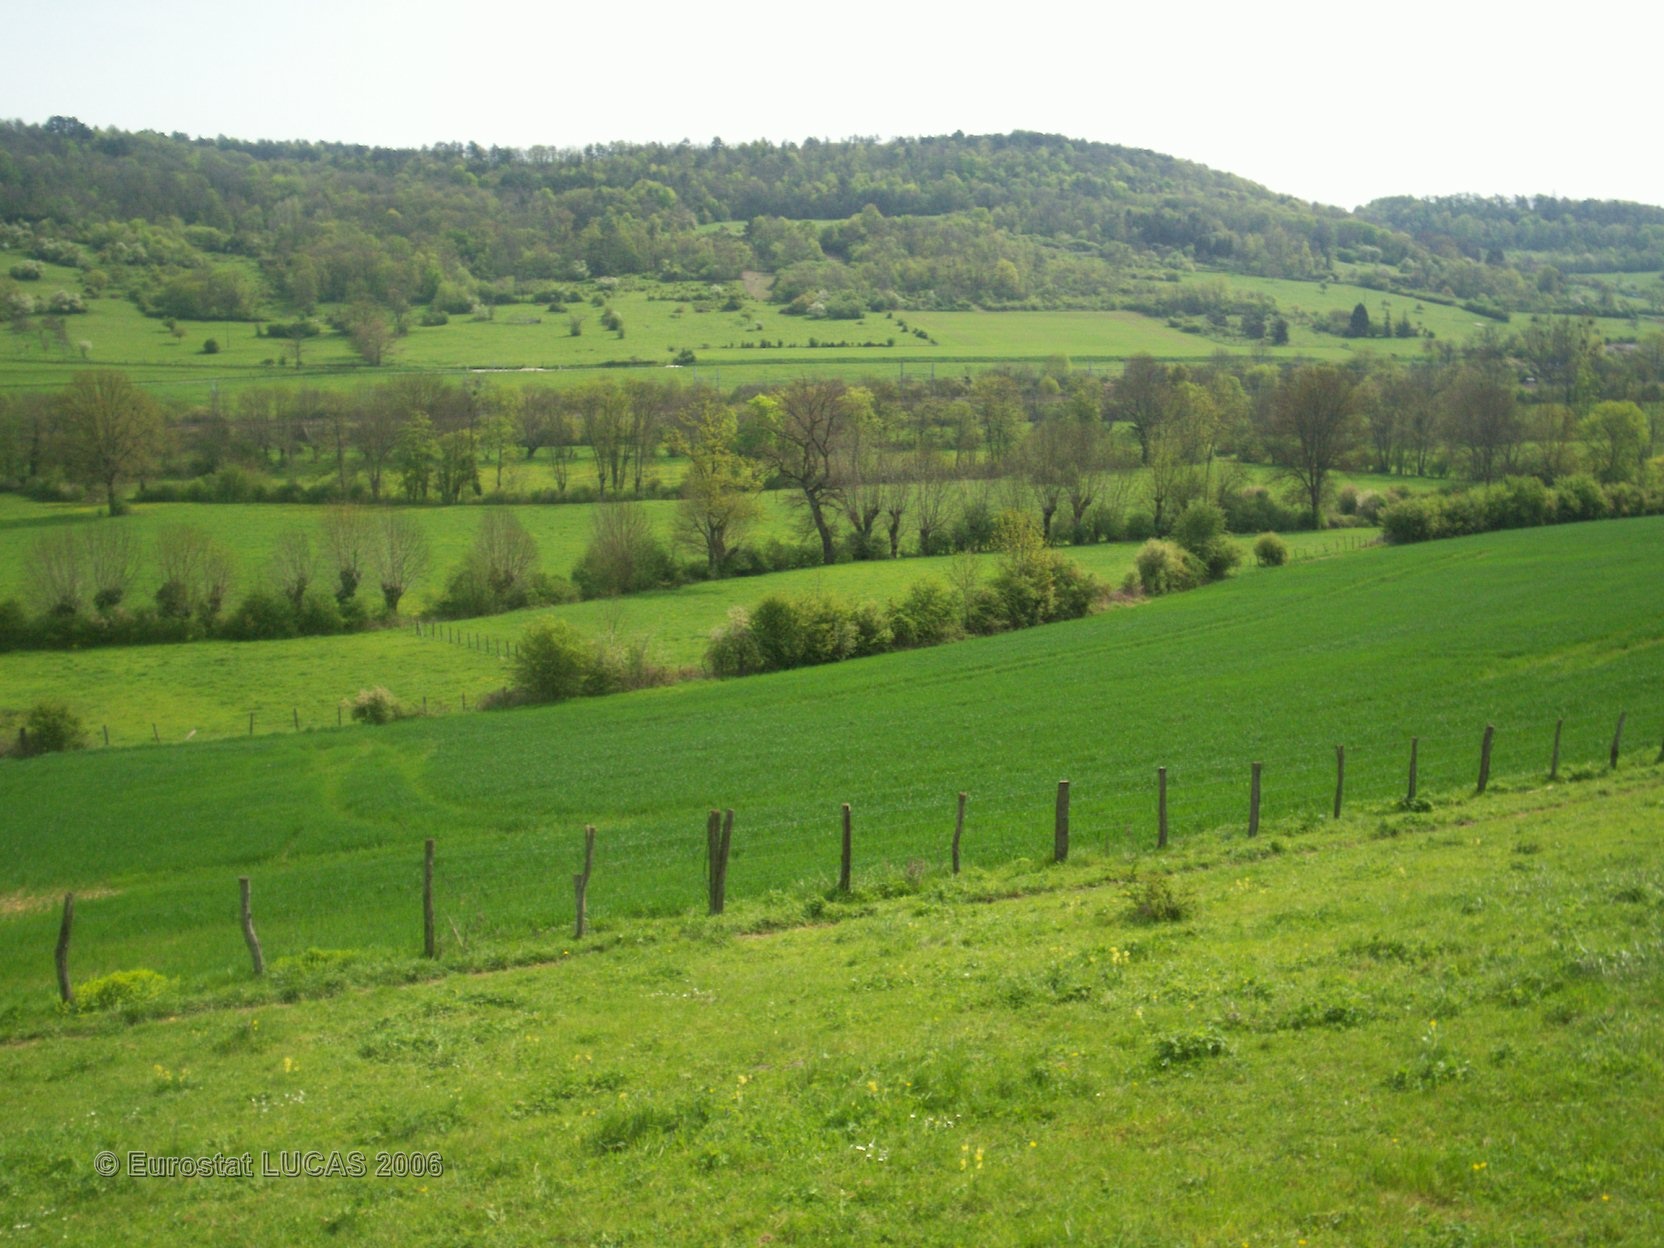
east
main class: Grassland
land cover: Grassland without tree/shrub cover
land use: Agriculture (excluding fallow land and kitchen gardens)
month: May
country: FR
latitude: 47.4446
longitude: 4.6552
